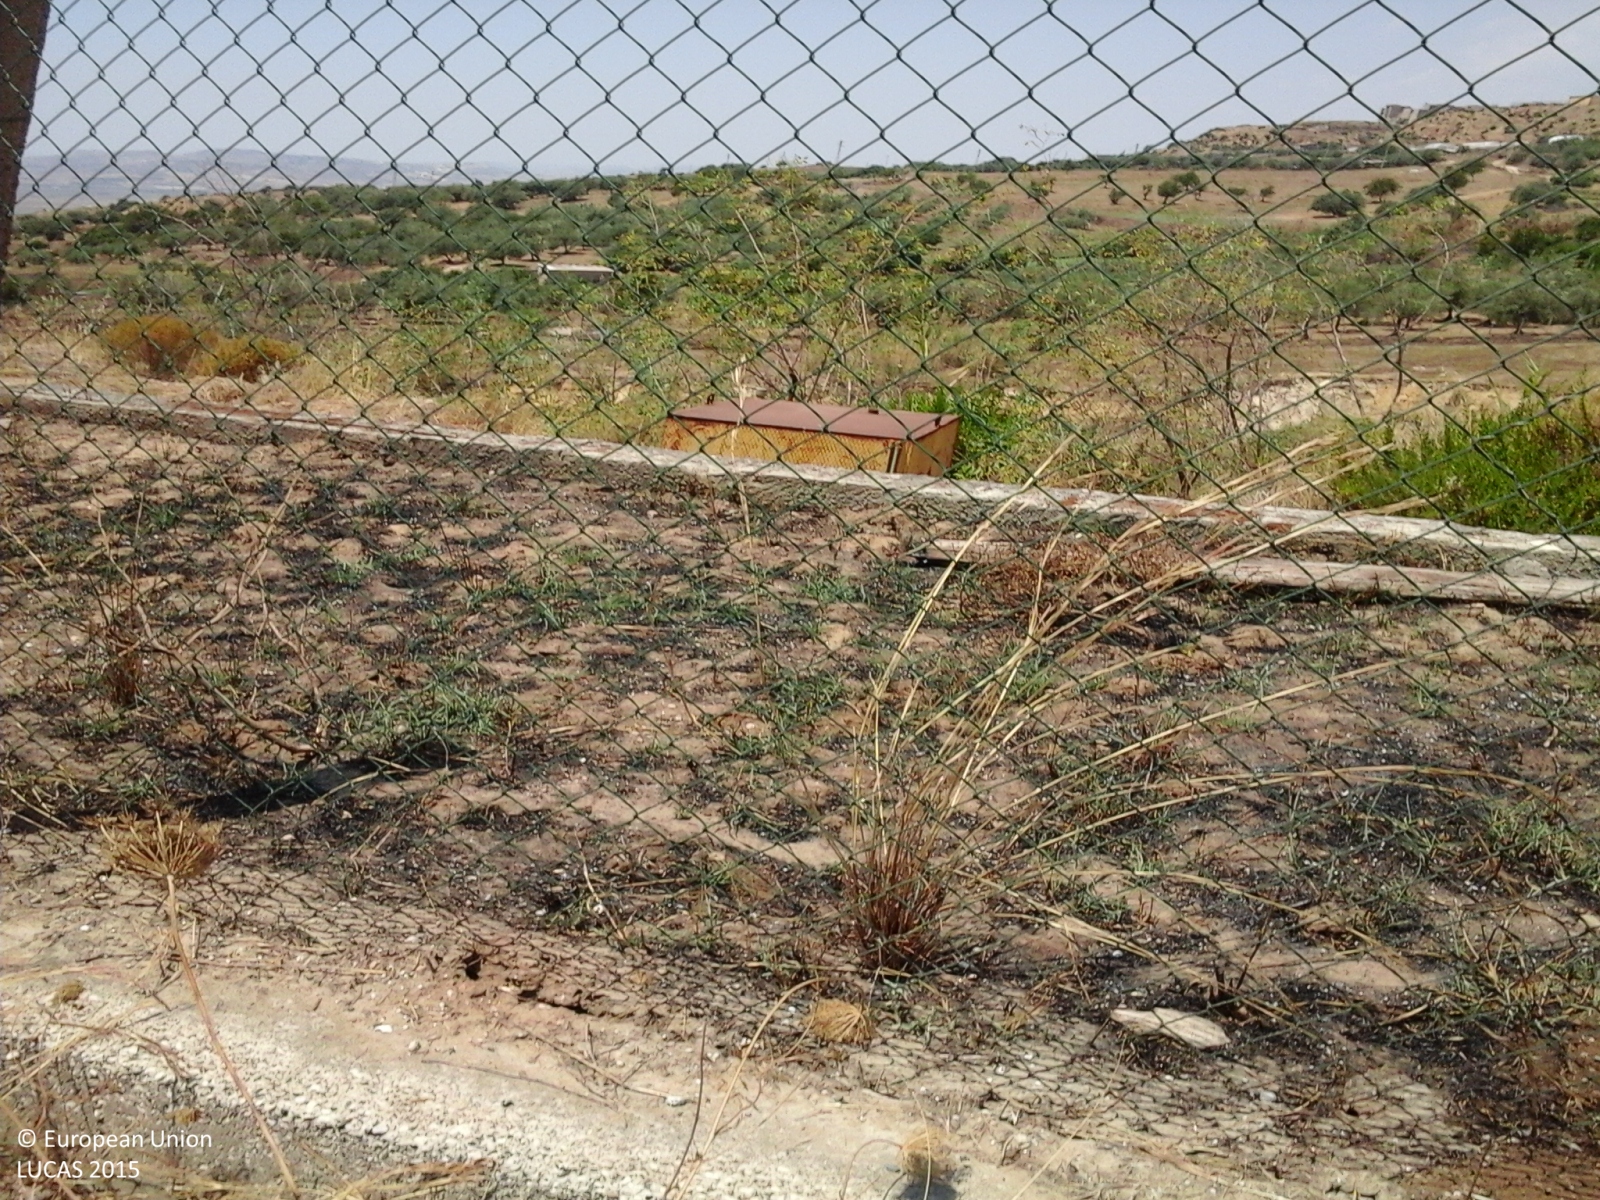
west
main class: Cropland
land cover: Olive groves
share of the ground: > 75 %
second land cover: Other bare soil
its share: > 75 %
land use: Agriculture (excluding fallow land and kitchen gardens)
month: July
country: IT
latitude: 37.1371
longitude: 14.3899
